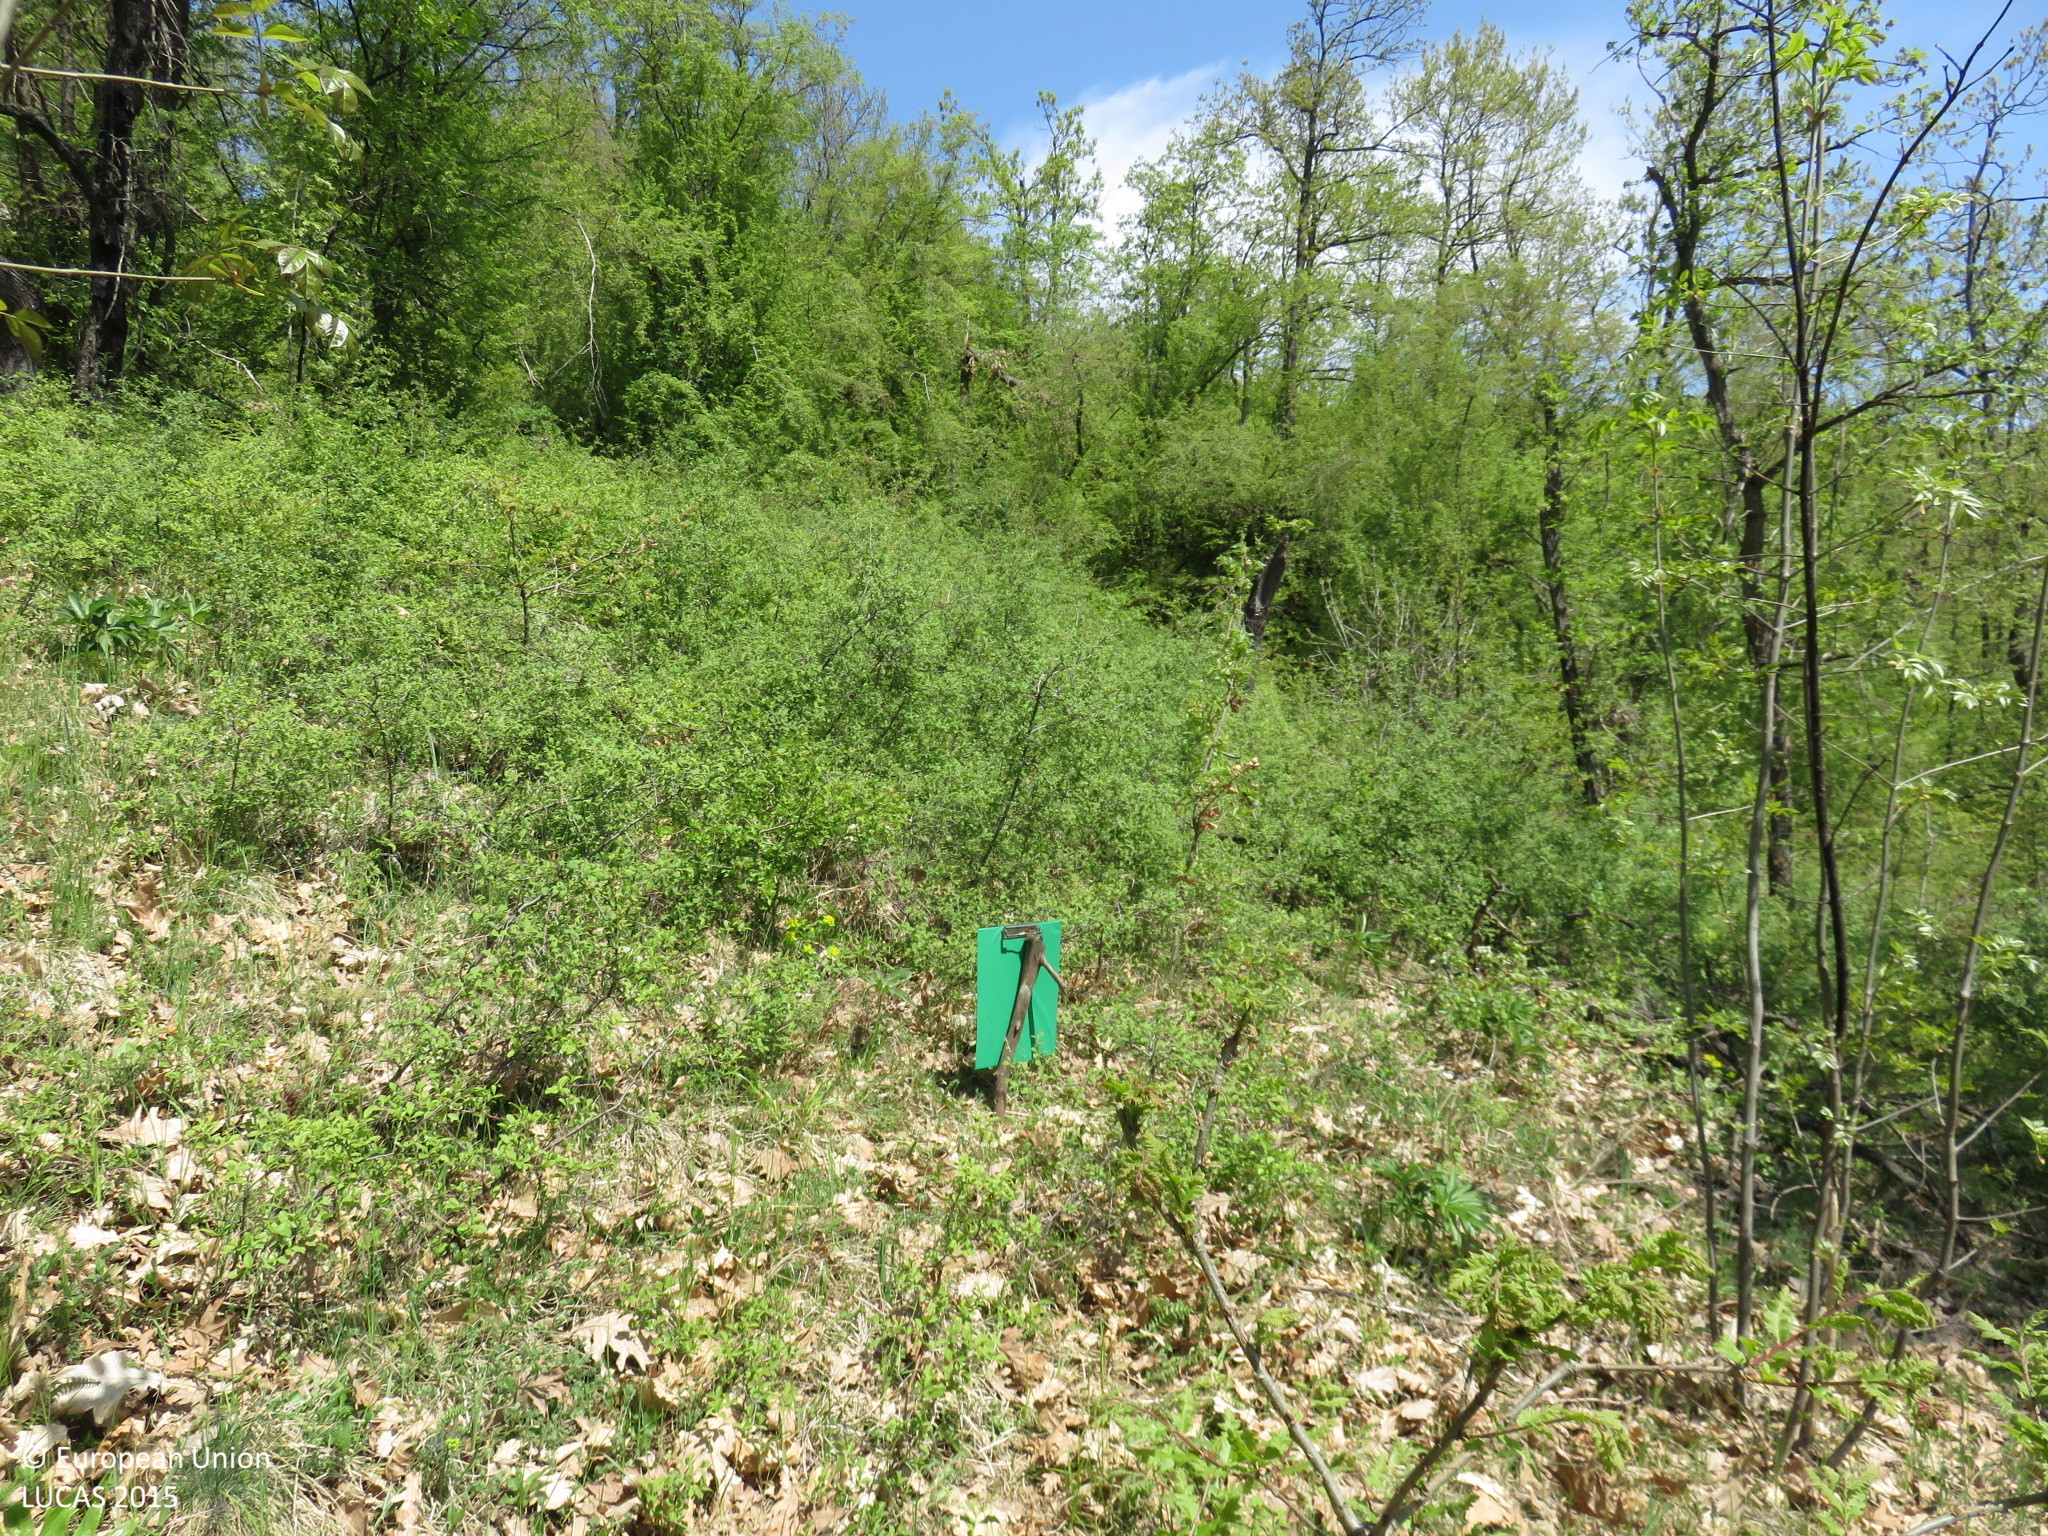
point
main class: Woodland
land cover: Broadleaved woodland
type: mesophytic deciduous forest
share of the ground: 50 - 75 %
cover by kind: broadleaved forest trees 55 %, shrubs 40 %, herbaceous plants 5 %
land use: Semi-natural and natural areas not in use
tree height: < 5 m
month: April
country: BG
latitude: 43.0293
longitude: 24.7767
